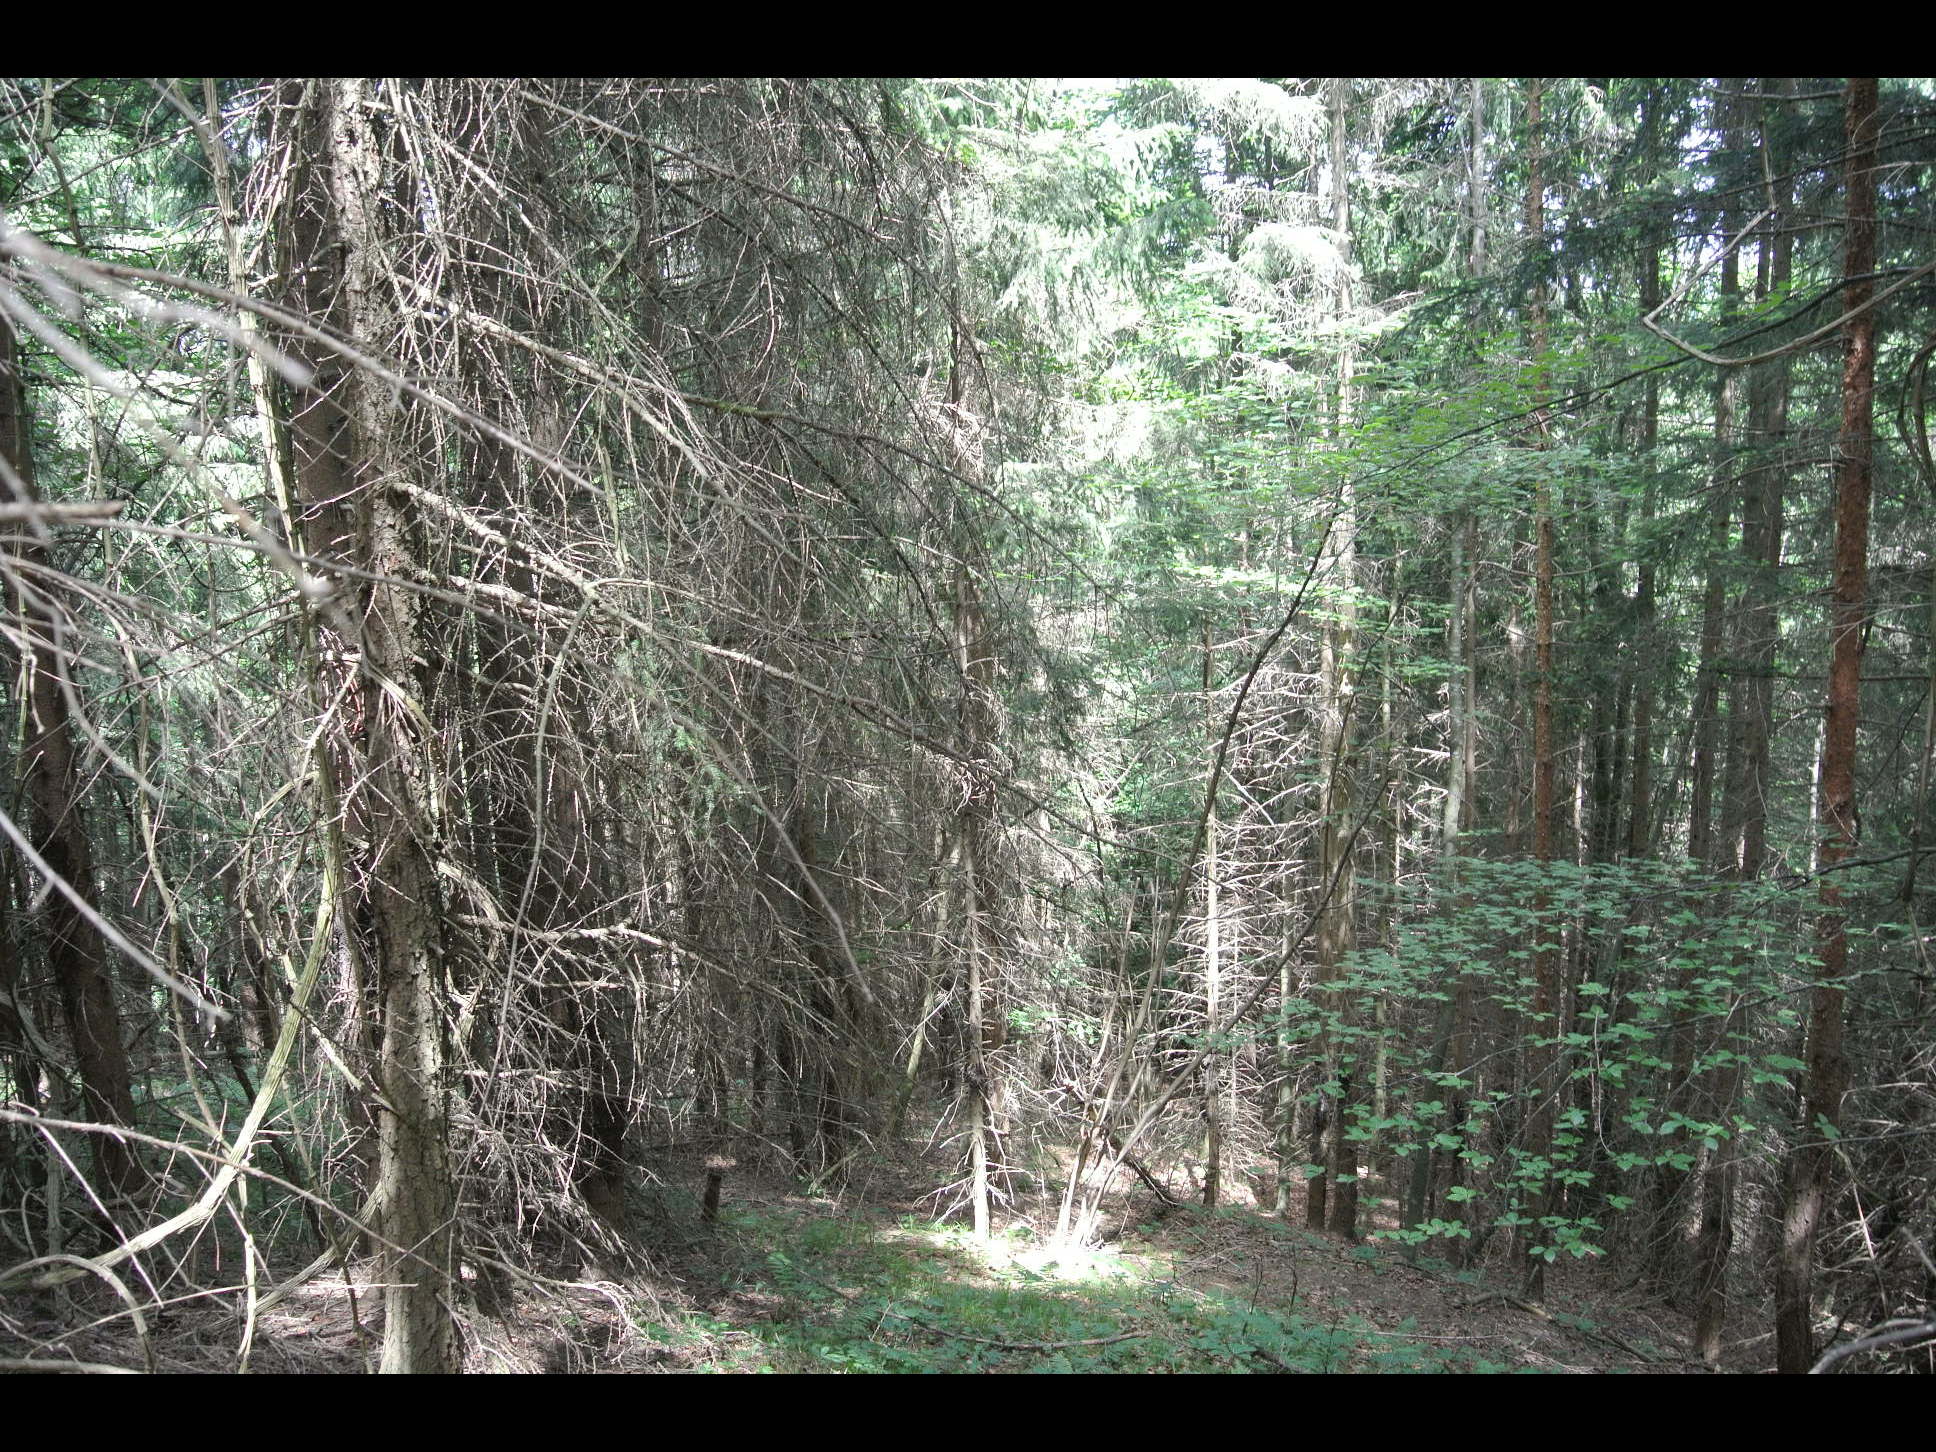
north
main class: Woodland
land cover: Spruce dominated coniferous woodland
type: alpine coniferous forest
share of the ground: > 75 %
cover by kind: coniferous forest trees 95 %, broadleaved forest trees 5 %
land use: Forestry
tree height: > 5 m
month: May
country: AT
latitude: 47.9970
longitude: 15.8326
